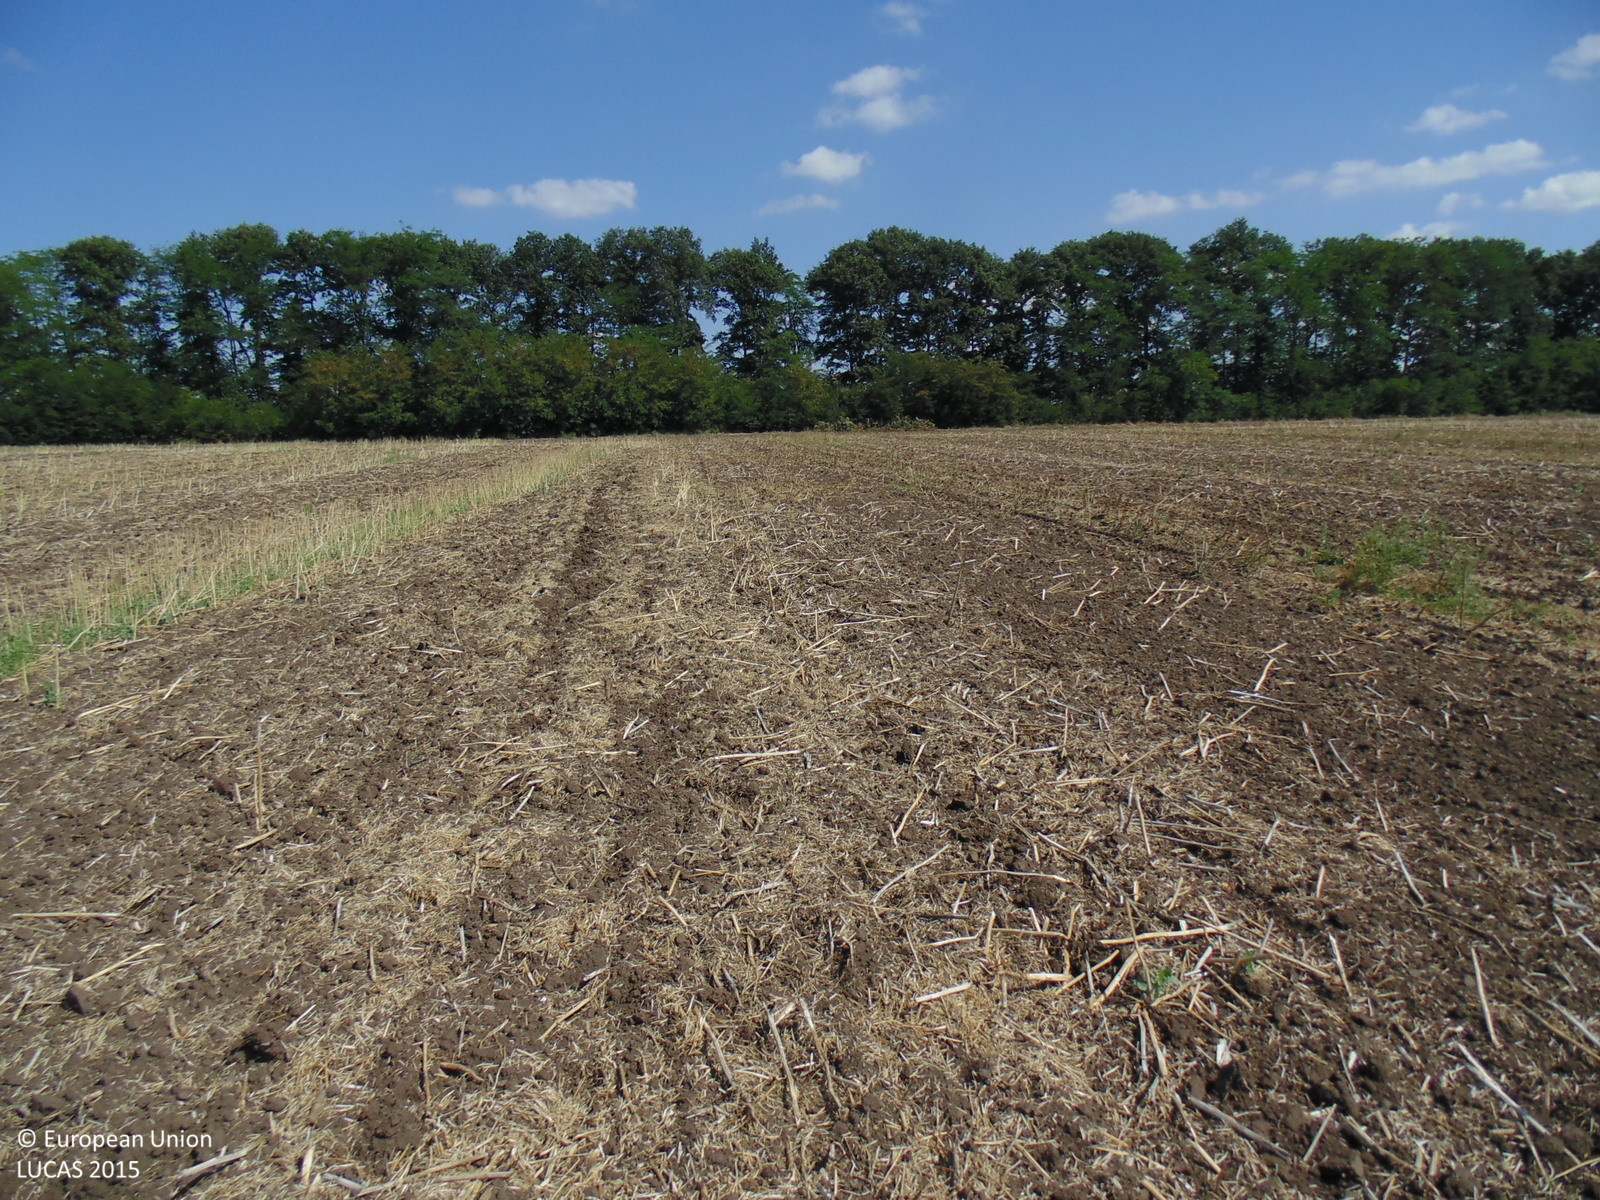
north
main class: Cropland
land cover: Rape and turnip rape
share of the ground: < 10 %
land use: Agriculture (excluding fallow land and kitchen gardens)
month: August
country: BG
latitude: 43.6789
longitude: 28.1253
